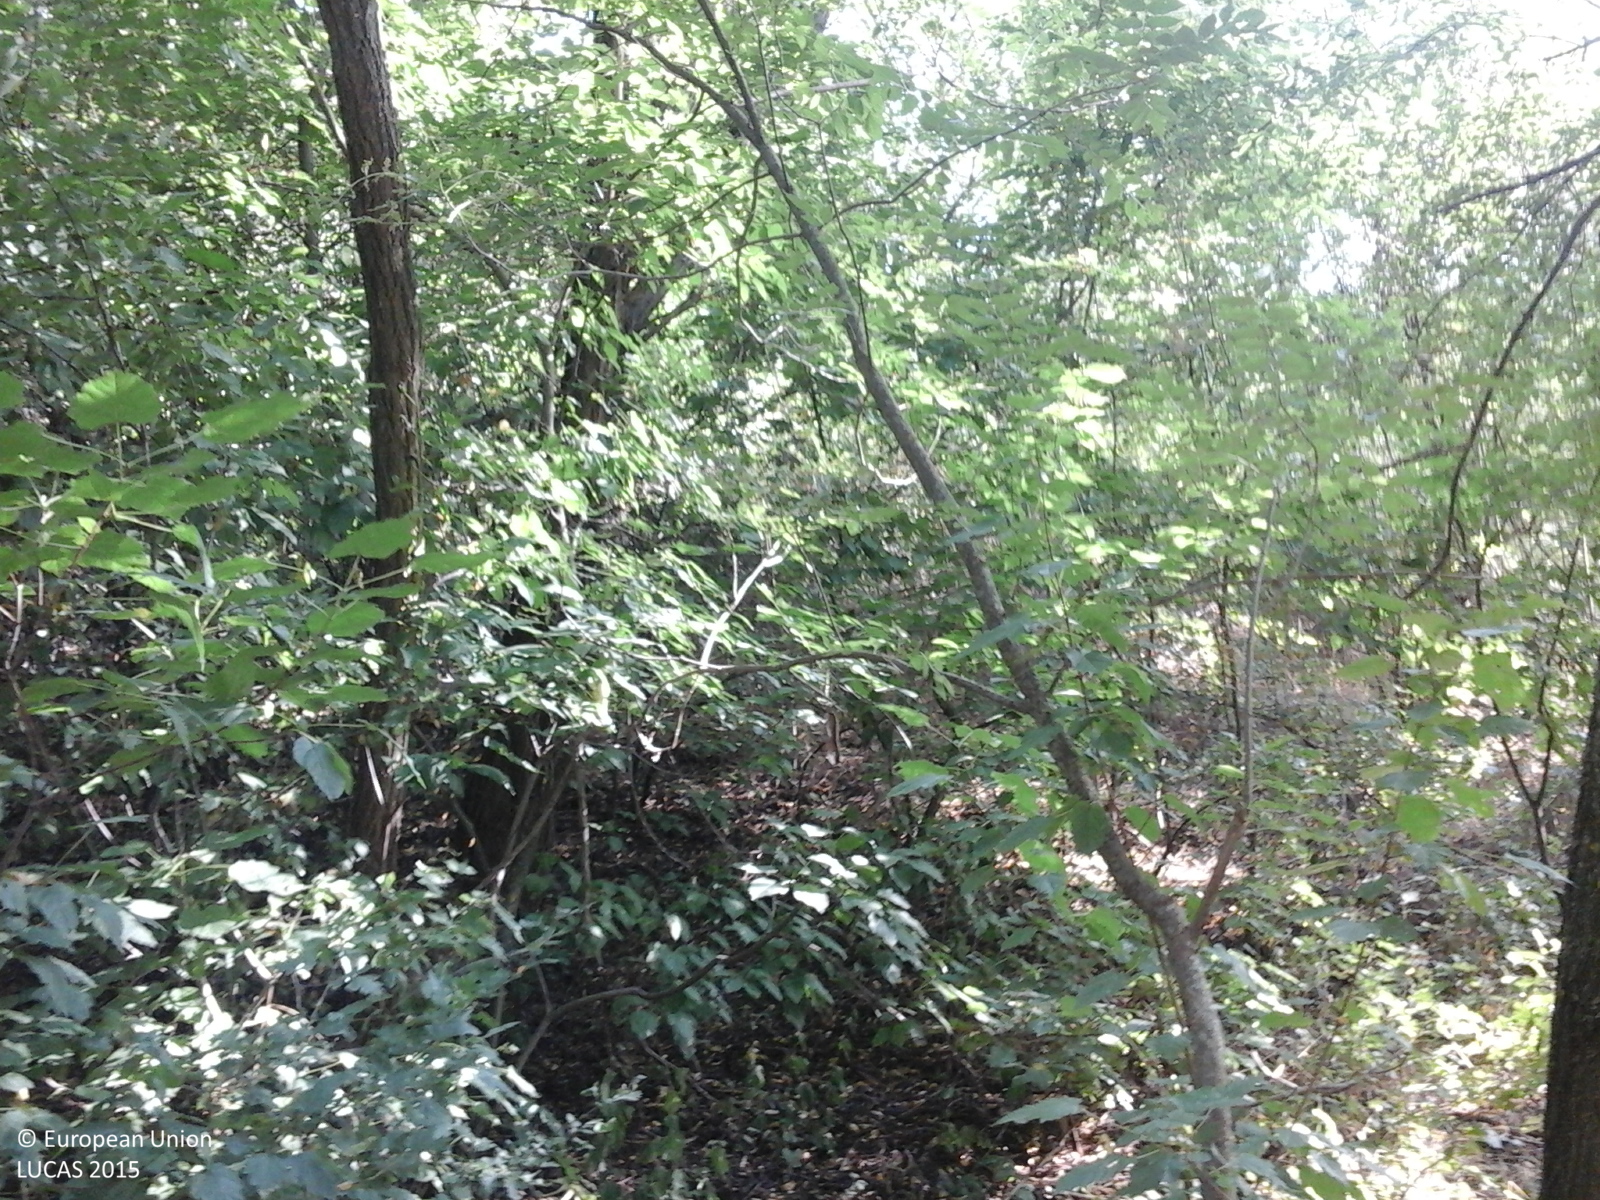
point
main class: Woodland
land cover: Broadleaved woodland
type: mesophytic deciduous forest
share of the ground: > 75 %
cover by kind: broadleaved forest trees 80 %, shrubs 10 %, herbaceous plants 10 %
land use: Forestry
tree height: > 5 m
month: July
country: RO
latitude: 46.1517
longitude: 27.5769
